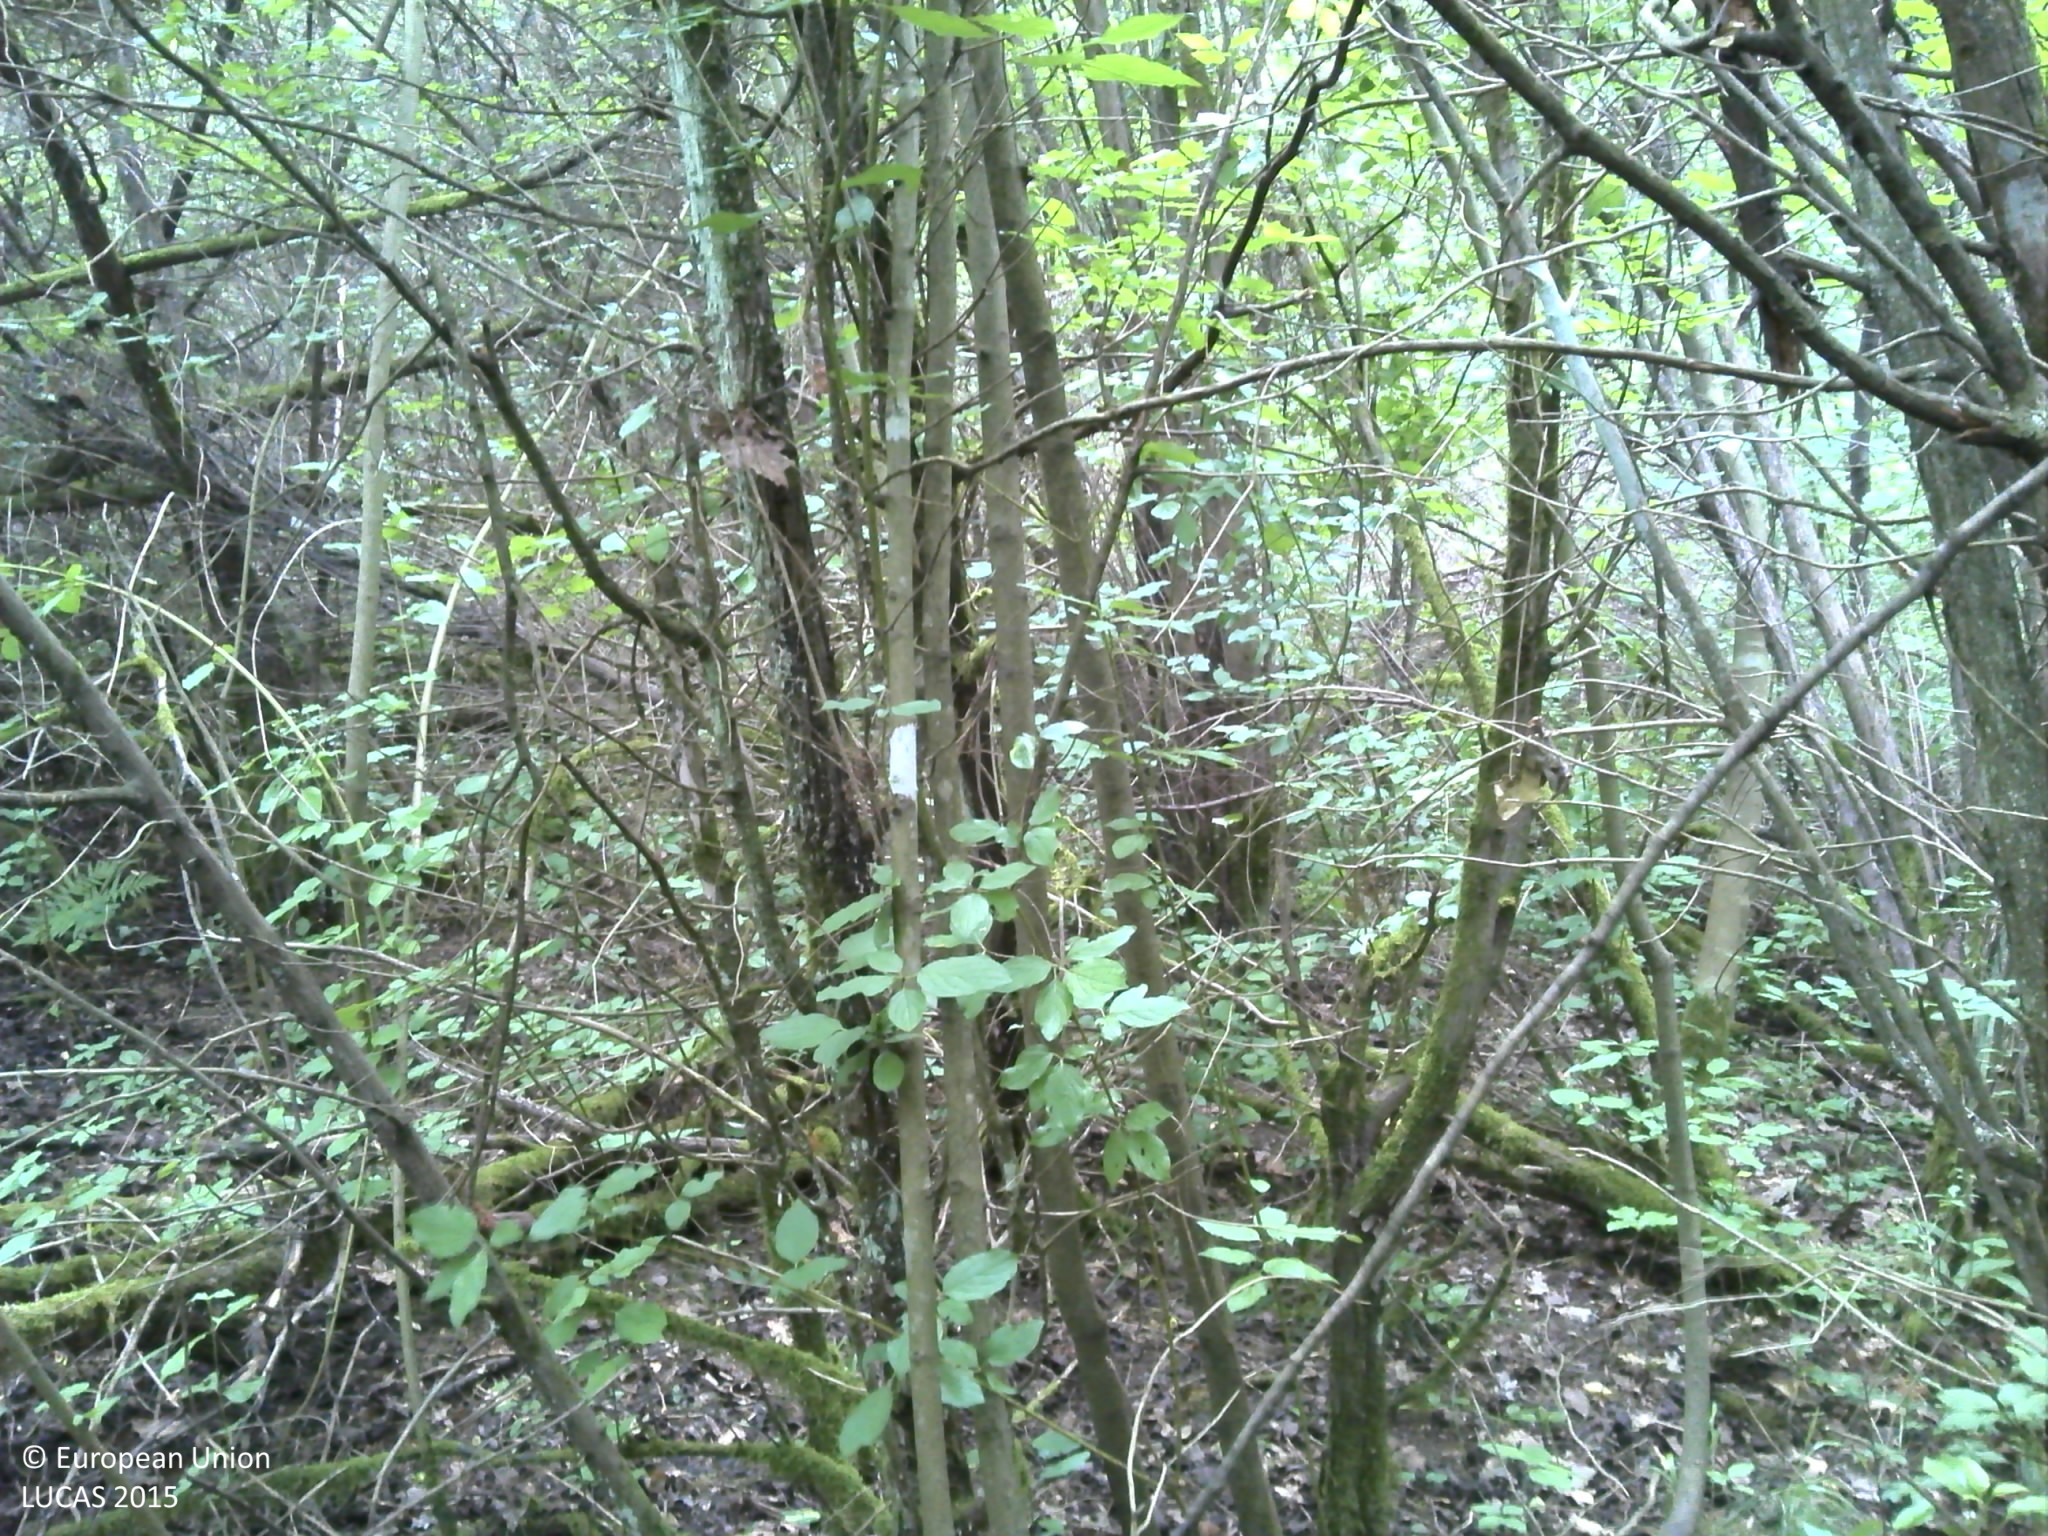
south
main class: Woodland
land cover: Broadleaved woodland
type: beech forest
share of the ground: > 75 %
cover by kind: broadleaved forest trees 100 %
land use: Forestry
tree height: > 5 m
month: June
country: HR
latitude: 45.3841
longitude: 17.4723
